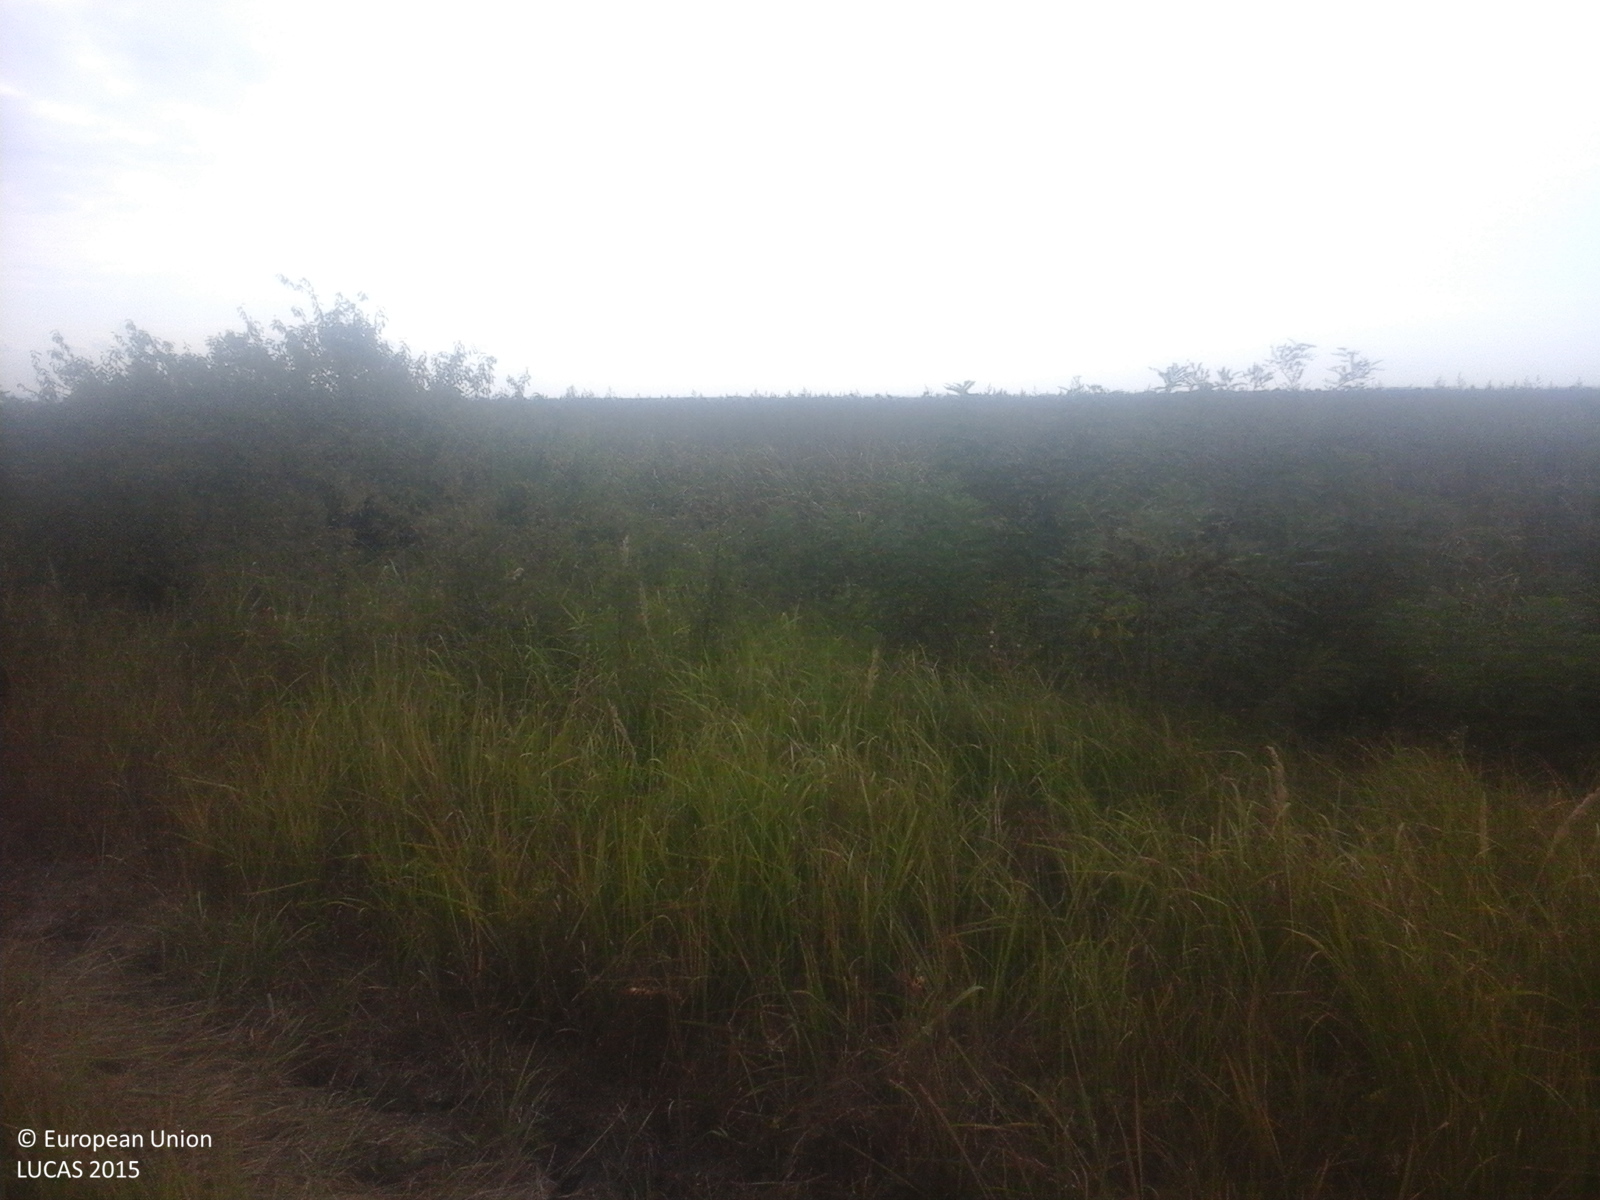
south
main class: Cropland
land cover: Maize
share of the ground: > 75 %
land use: Agriculture (excluding fallow land and kitchen gardens)
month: September
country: RO
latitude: 47.7685
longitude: 22.6162
